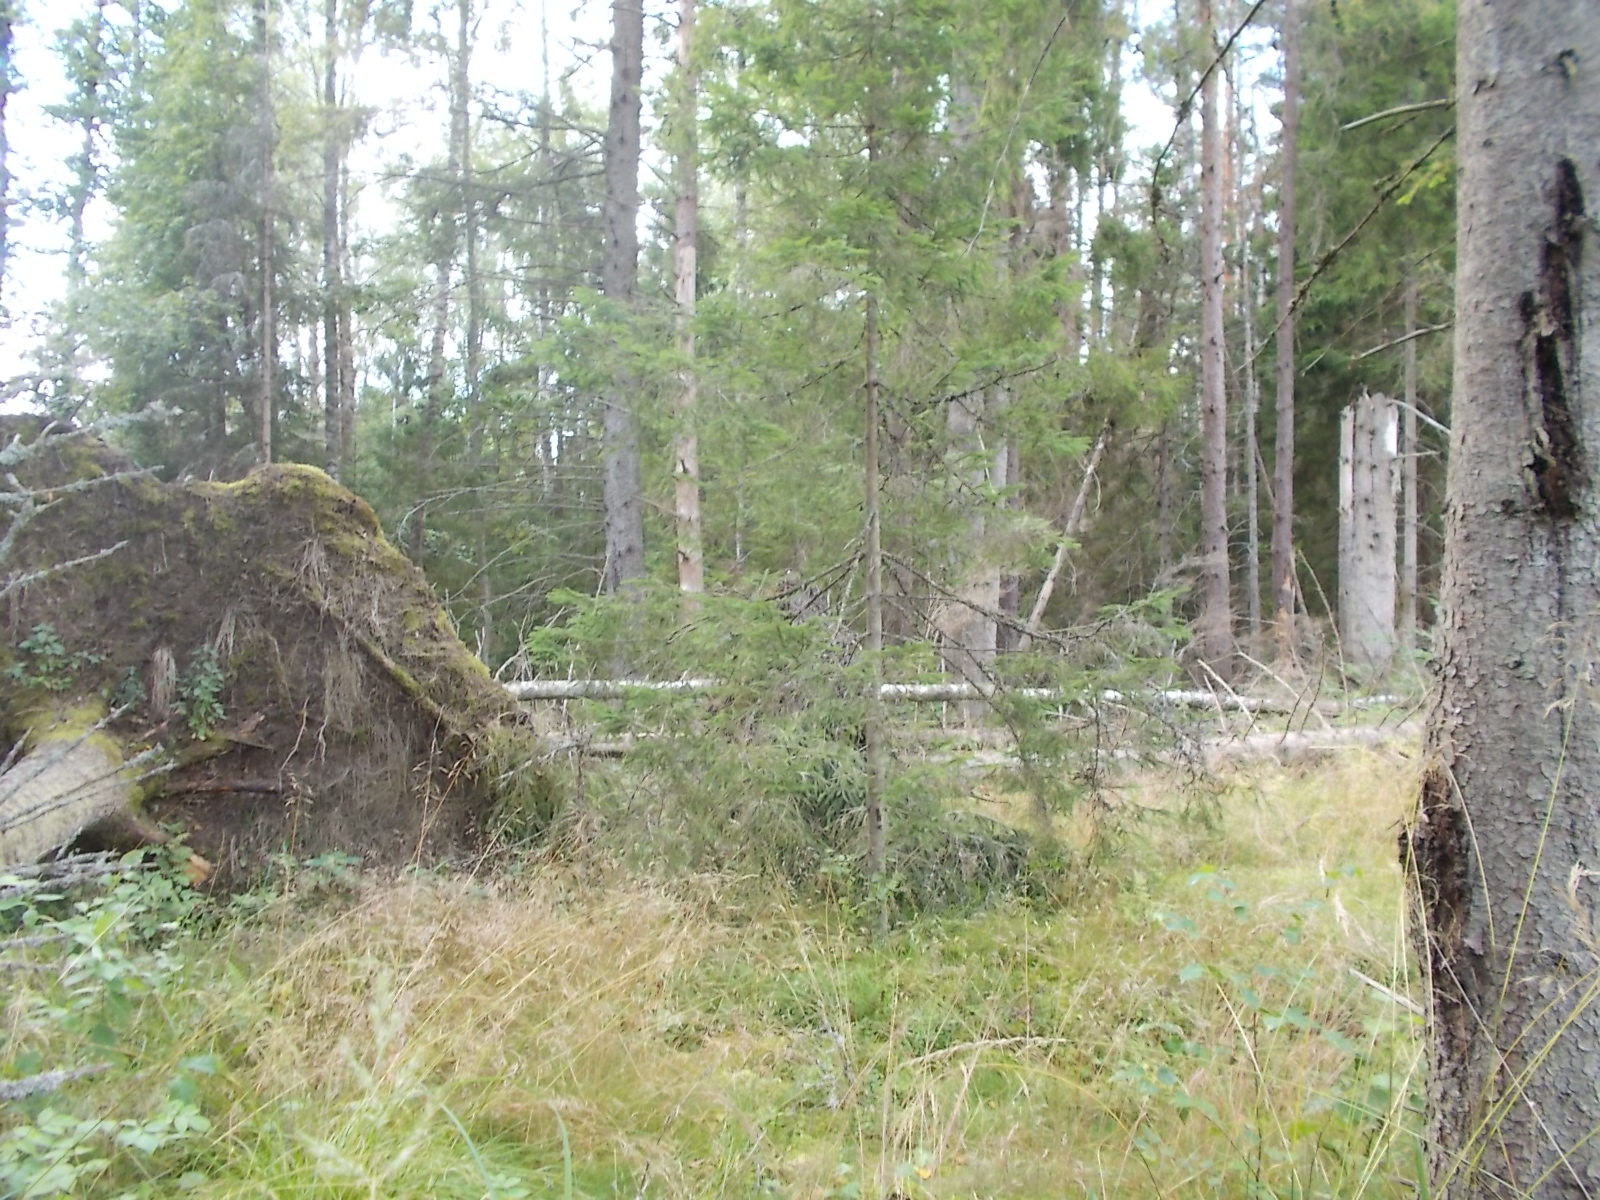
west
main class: Woodland
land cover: Other coniferous woodland
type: hemiboreal forest and nemoral coniferous forest and mixed broadleaved-coniferous forest
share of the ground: 50 - 75 %
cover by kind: coniferous forest trees 60 %, herbaceous plants 20 %, shrubs 15 %, broadleaved forest trees 5 %
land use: Forestry
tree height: > 5 m
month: August
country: LV
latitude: 57.0750
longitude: 21.8392
